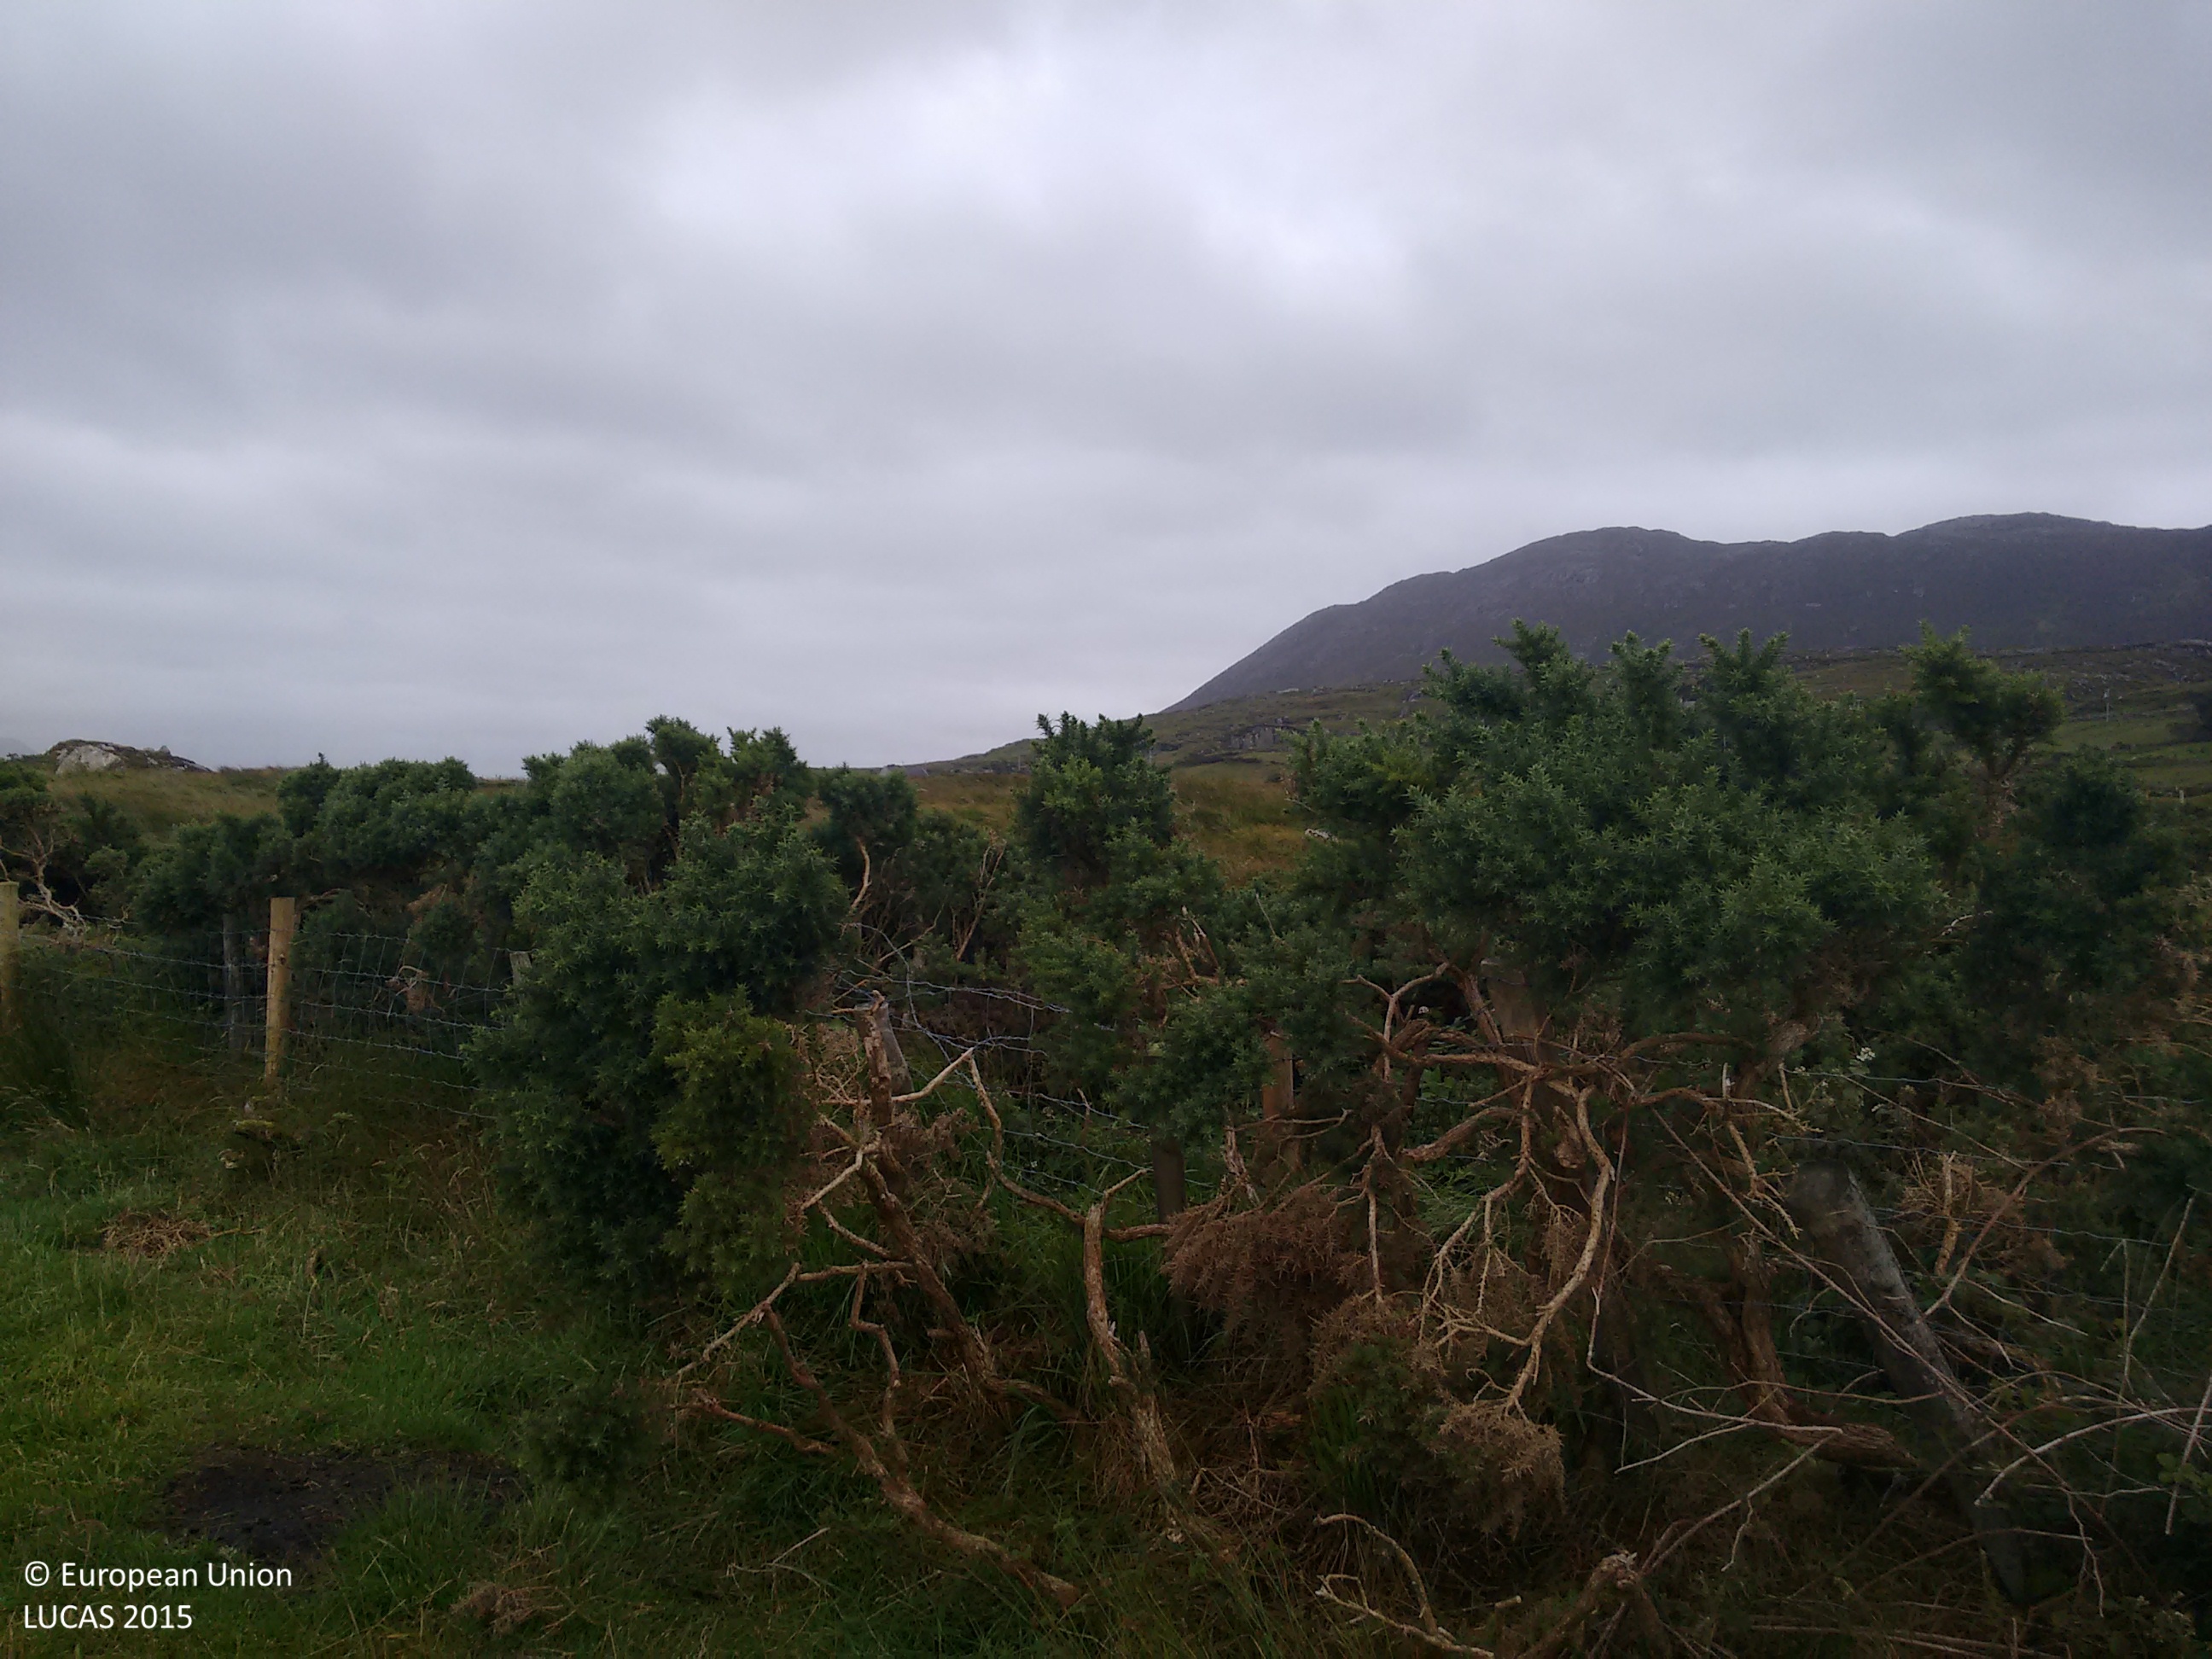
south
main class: Grassland
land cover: Grassland without tree/shrub cover
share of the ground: > 75 %
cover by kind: herbaceous plants 90 %, unconsolidated bare surface 10 %
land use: Agriculture (excluding fallow land and kitchen gardens)
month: August
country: IE
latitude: 53.6005
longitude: -10.0043
